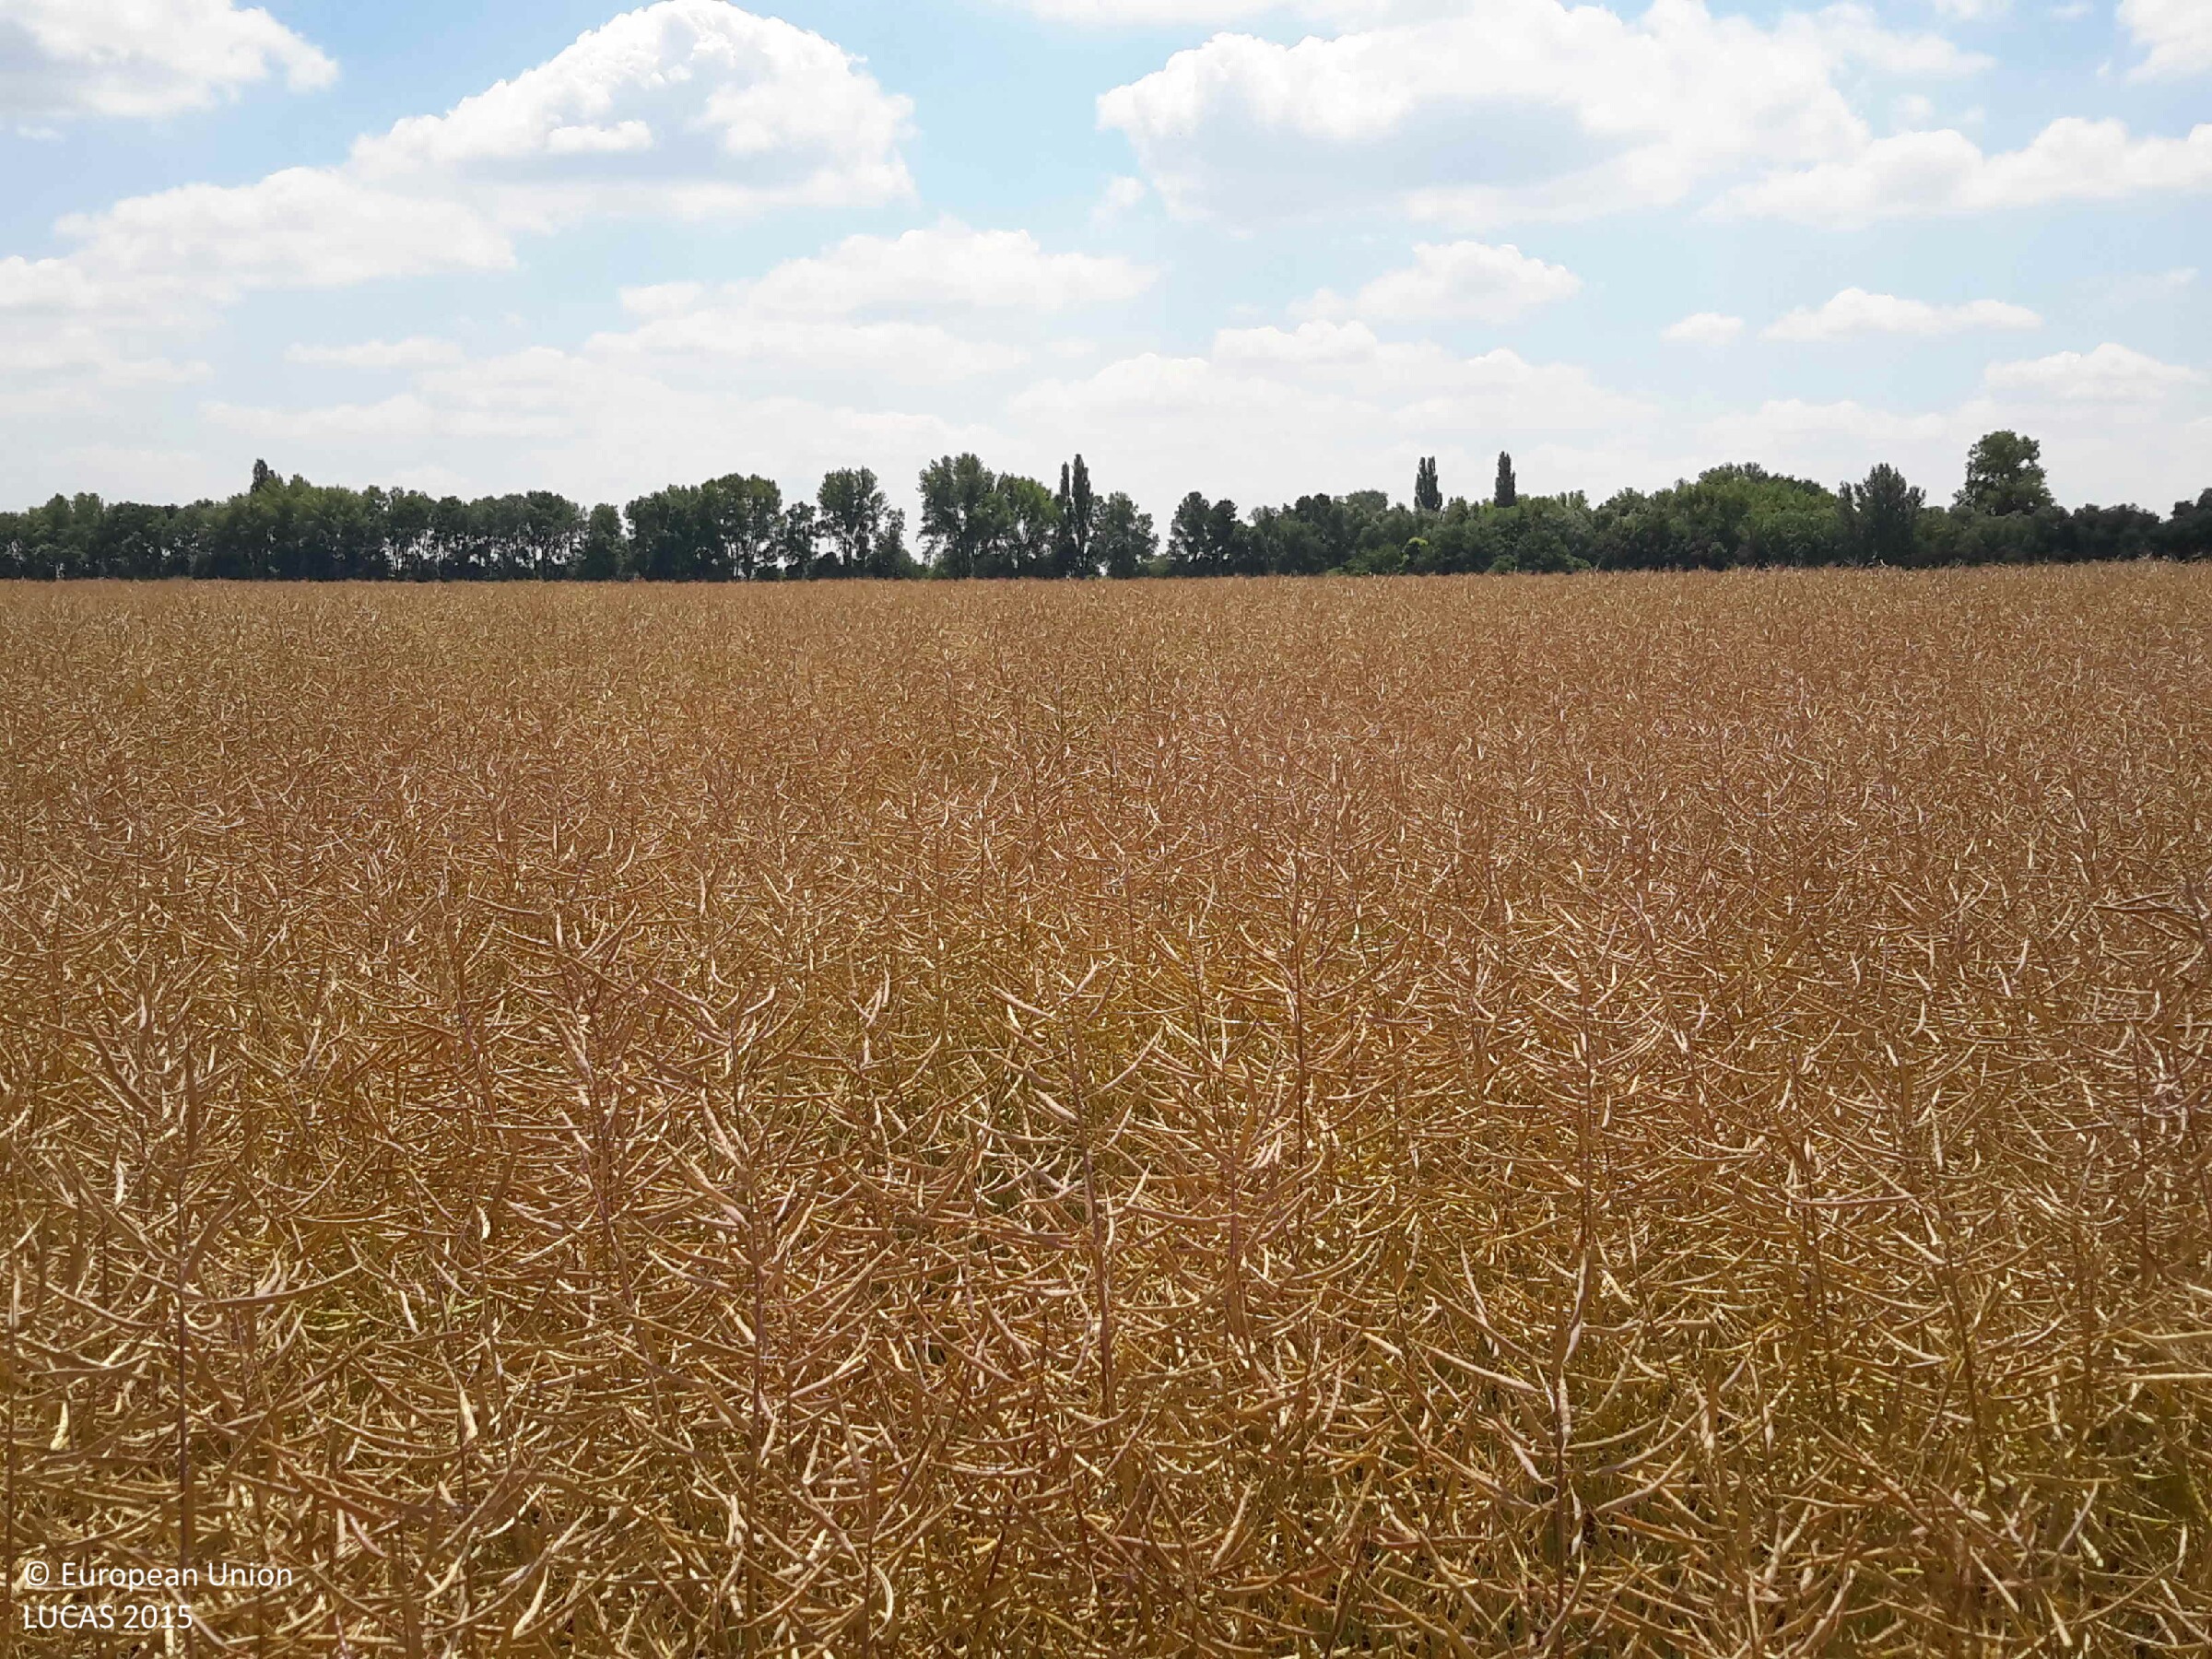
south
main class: Cropland
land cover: Rape and turnip rape
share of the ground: > 75 %
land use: Agriculture (excluding fallow land and kitchen gardens)
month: June
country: HU
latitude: 47.7534
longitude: 17.4653
